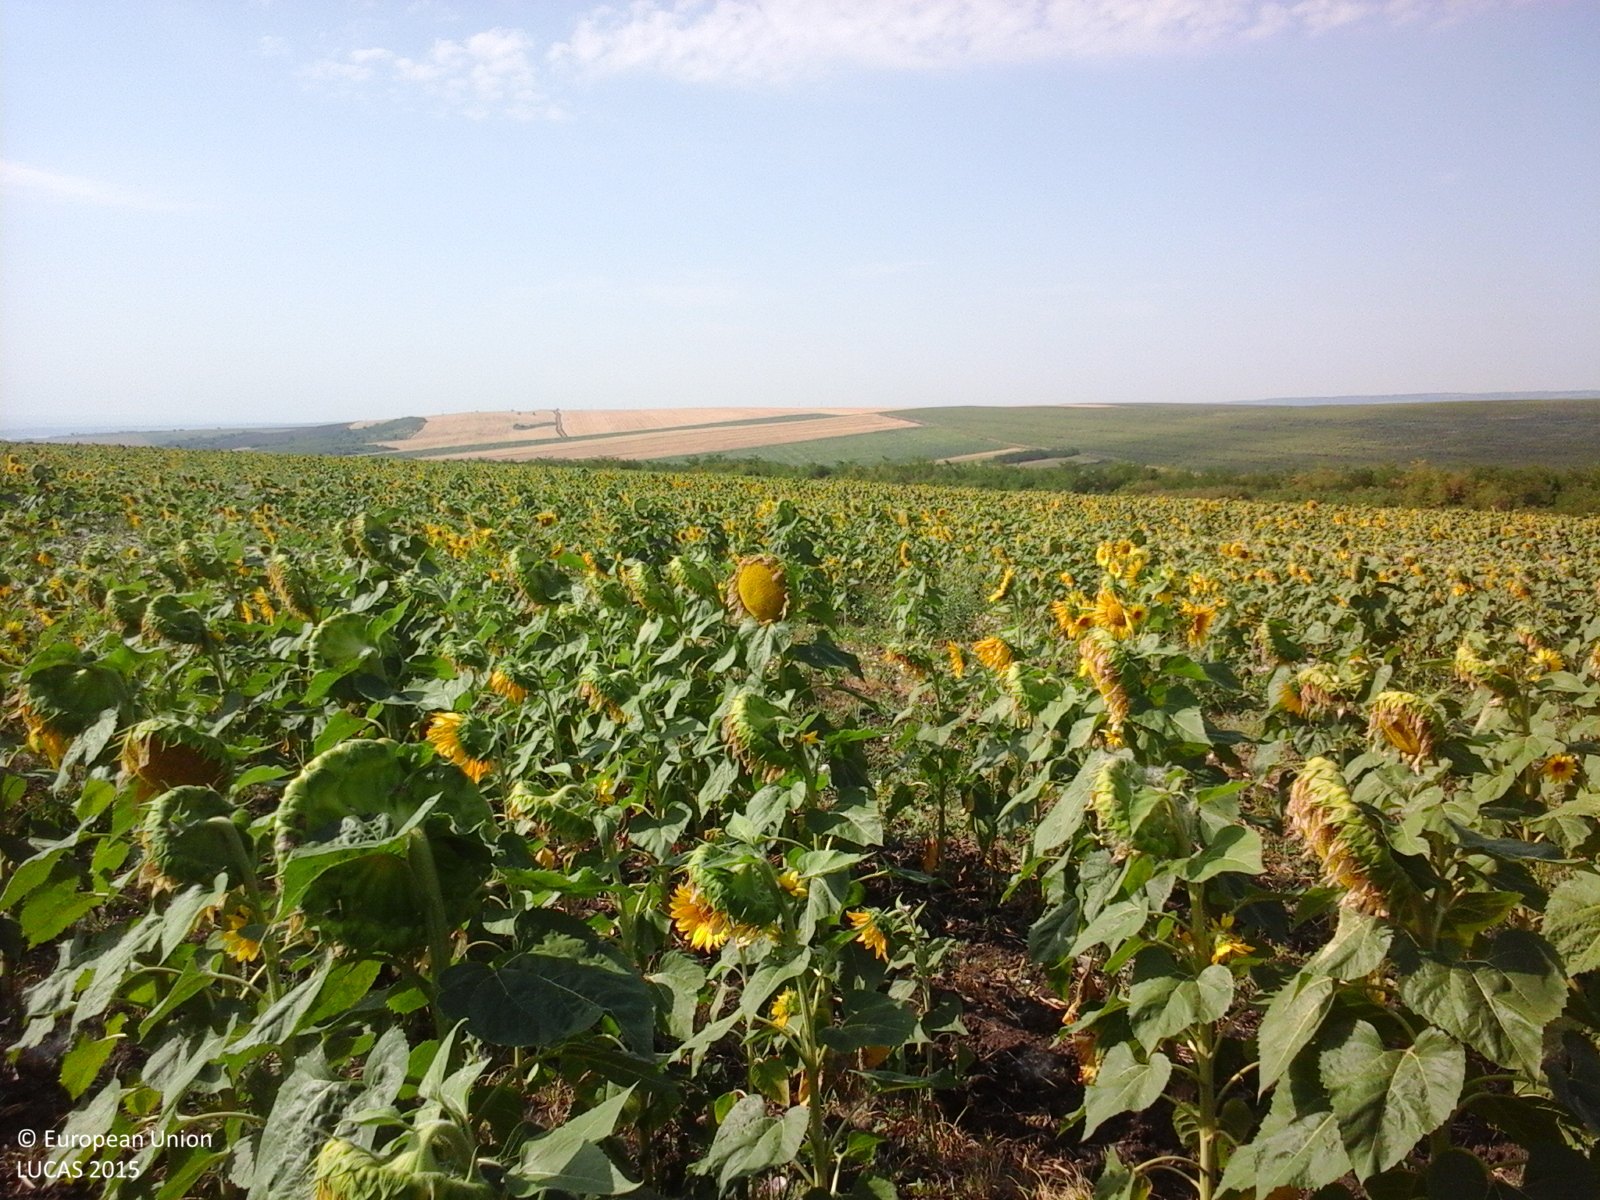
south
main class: Cropland
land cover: Sunflower
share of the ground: > 75 %
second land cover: Spontaneously vegetated surfaces
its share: 50 - 75 %
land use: Agriculture (excluding fallow land and kitchen gardens)
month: July
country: RO
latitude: 46.2529
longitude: 28.0663
